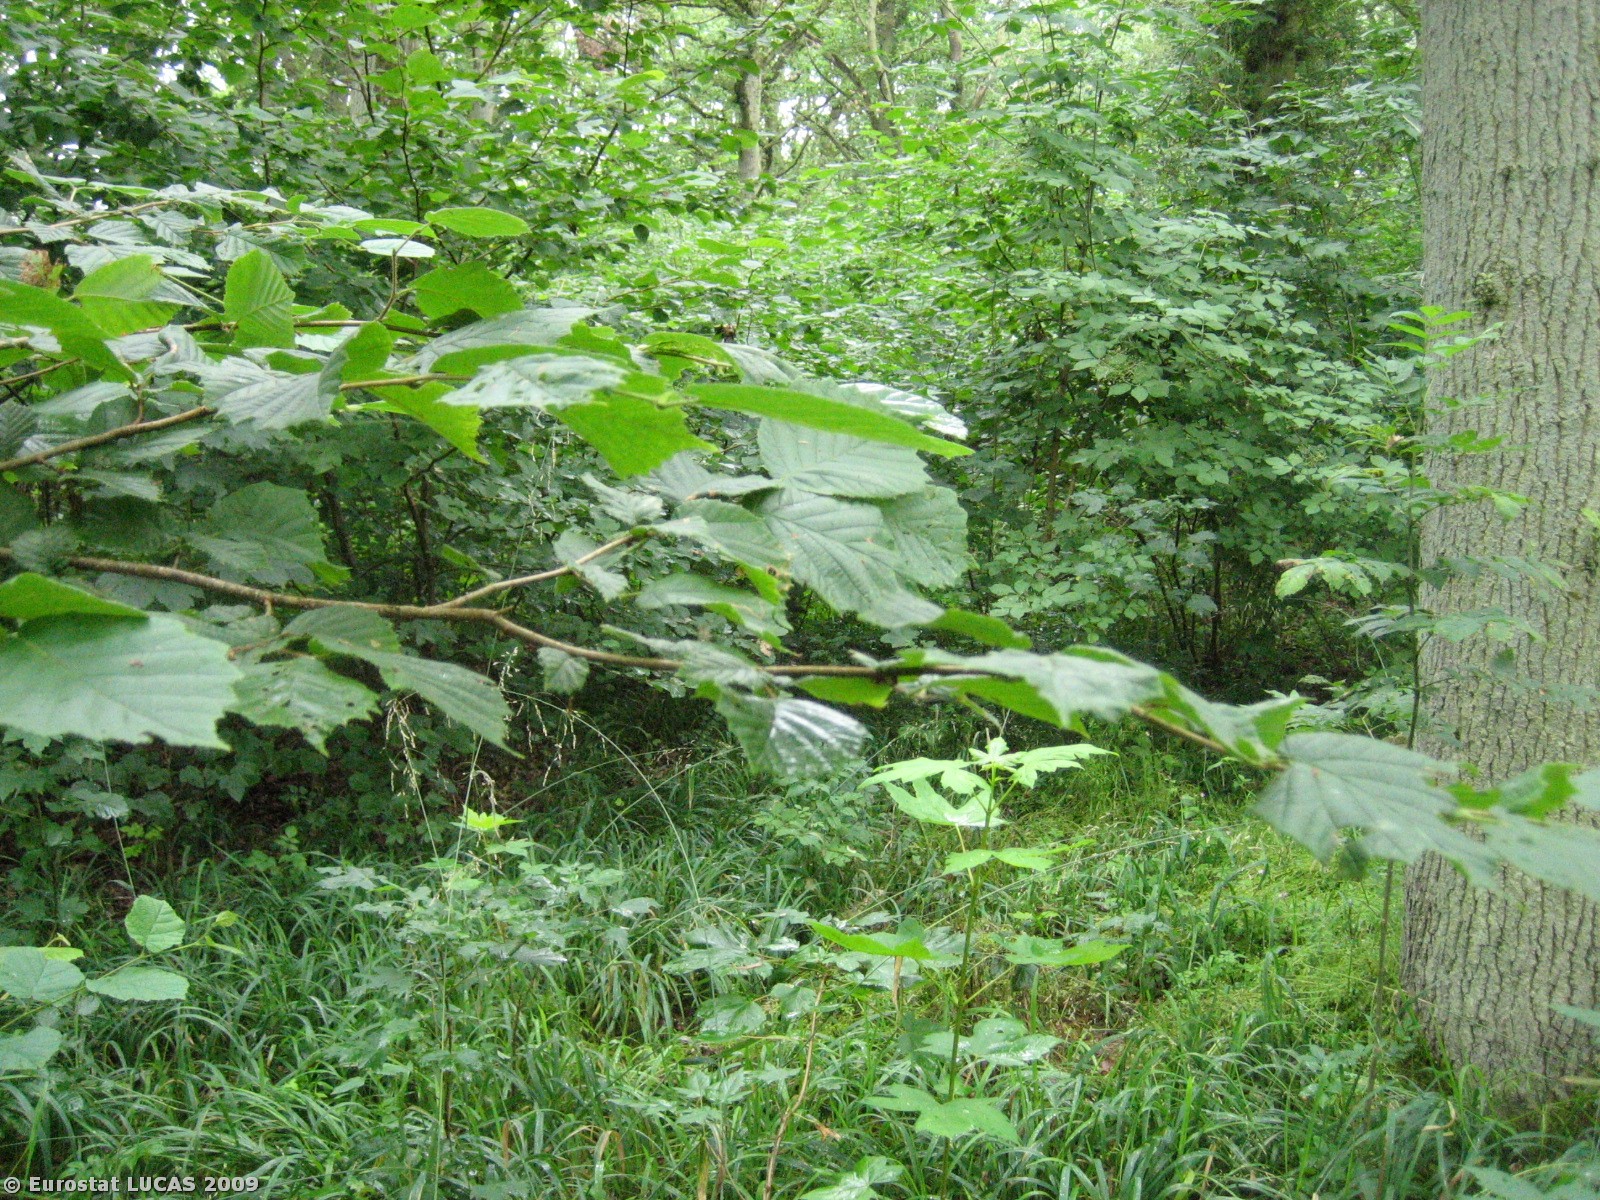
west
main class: Woodland
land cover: Broadleaved woodland
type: mesophytic deciduous forest
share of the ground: > 75 %
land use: Forestry
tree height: > 5 m
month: July
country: DK
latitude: 55.3609
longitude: 9.9212
